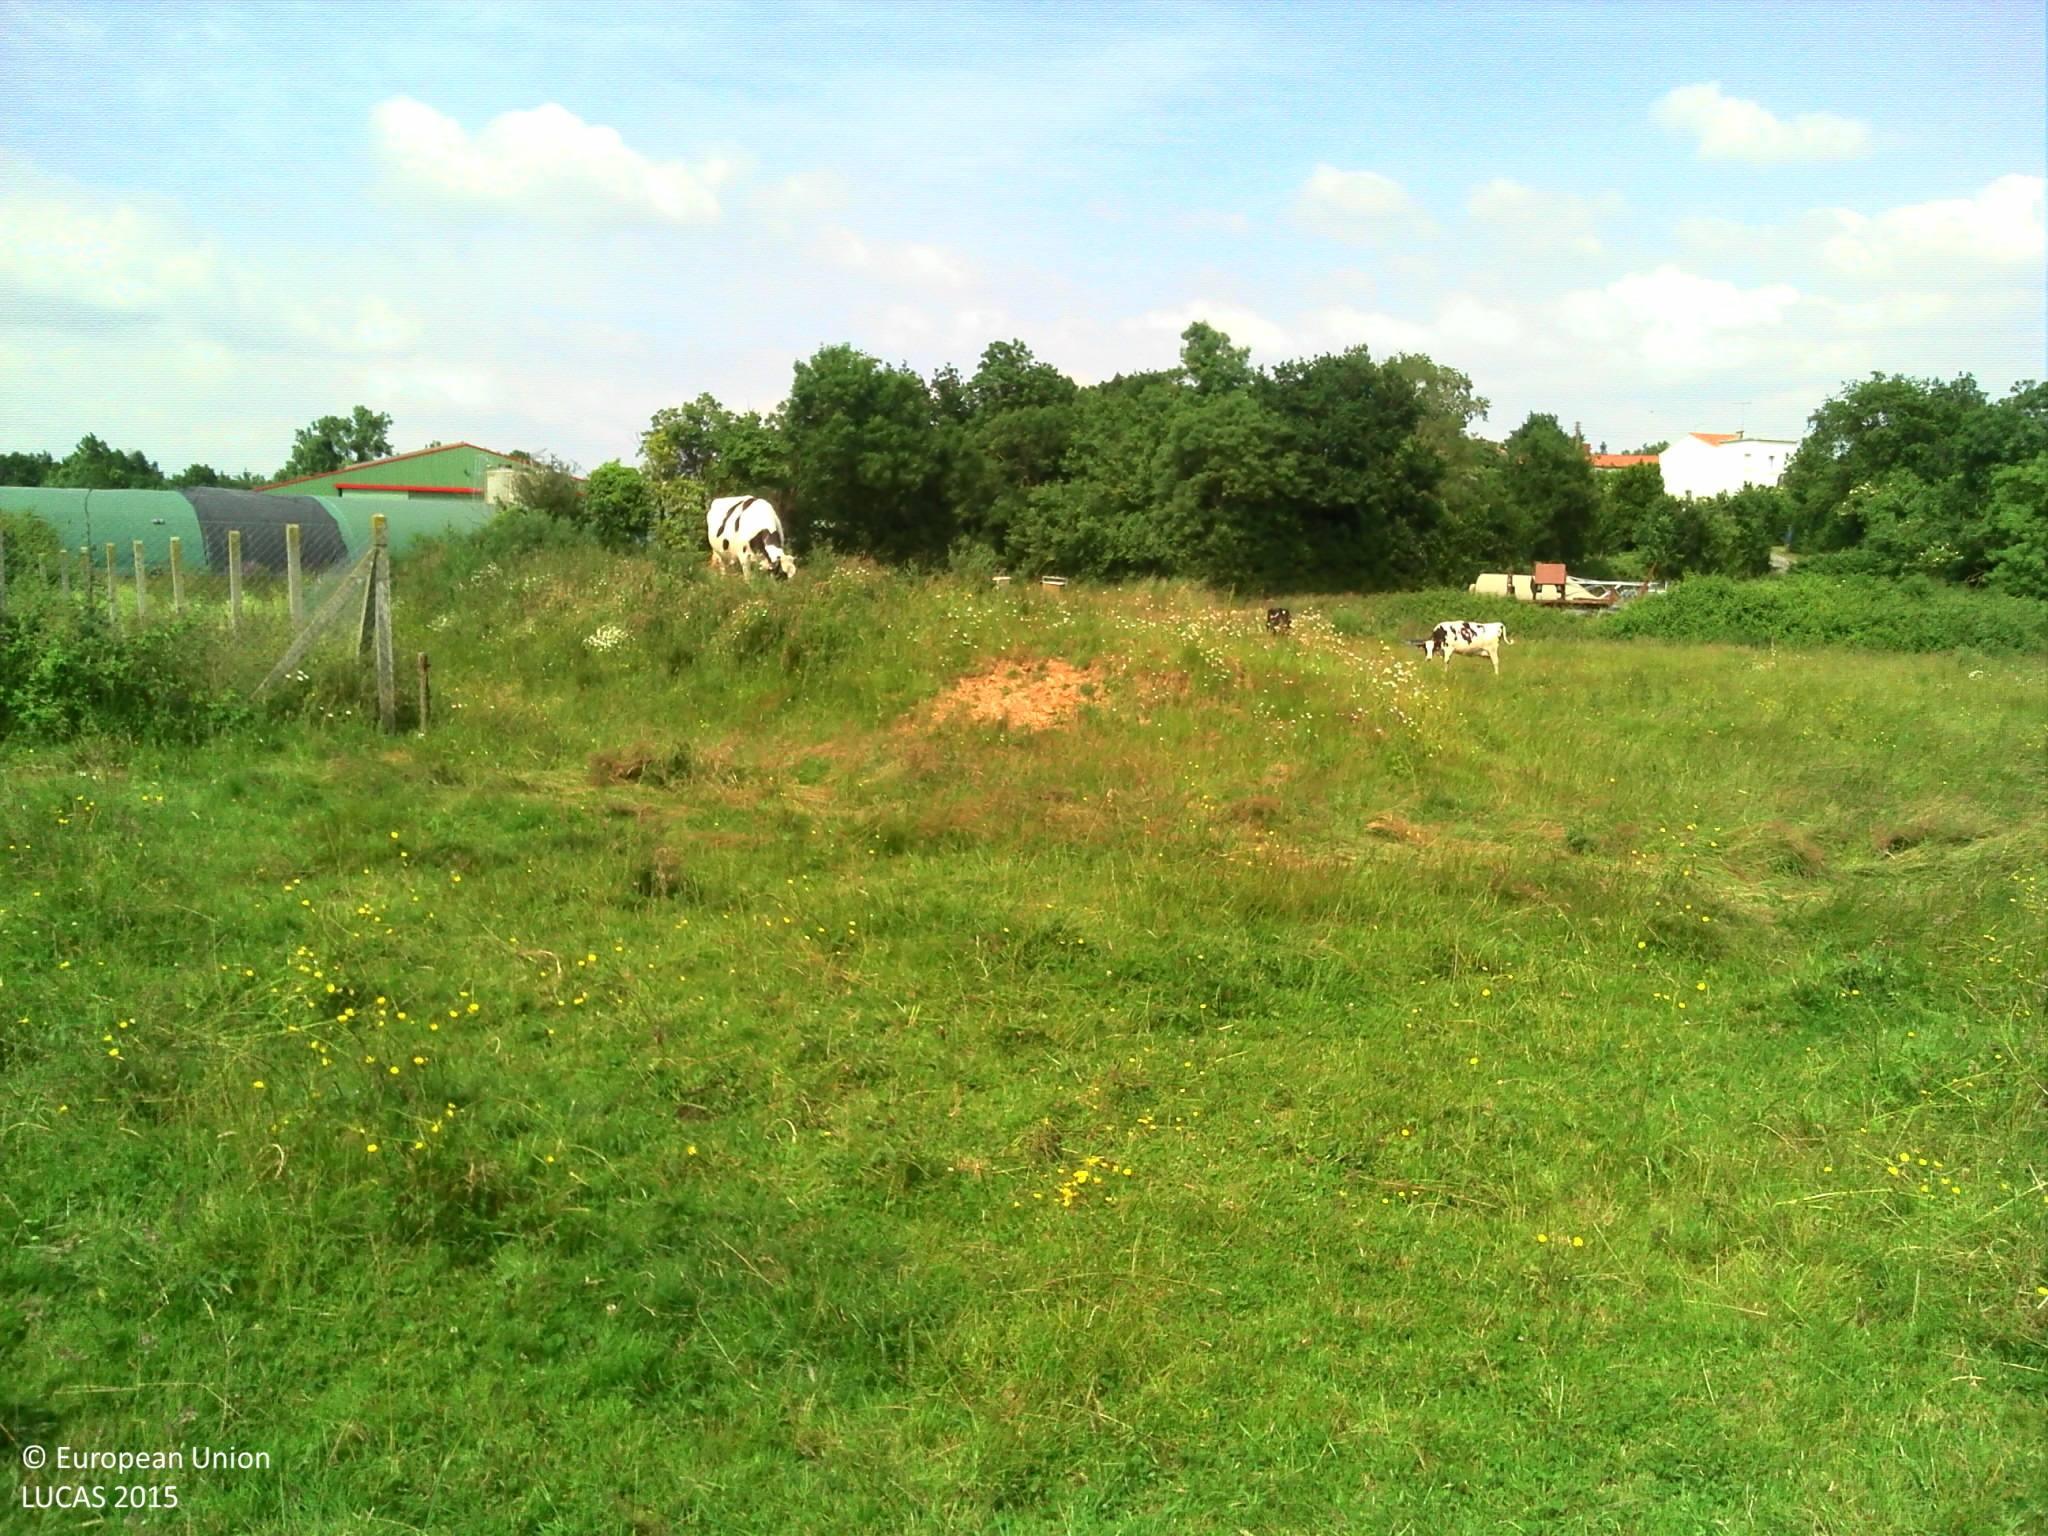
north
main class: Grassland
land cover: Grassland without tree/shrub cover
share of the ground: > 75 %
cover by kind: herbaceous plants 100 %
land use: Agriculture (excluding fallow land and kitchen gardens)
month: June
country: FR
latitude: 46.7871
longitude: -1.6339
